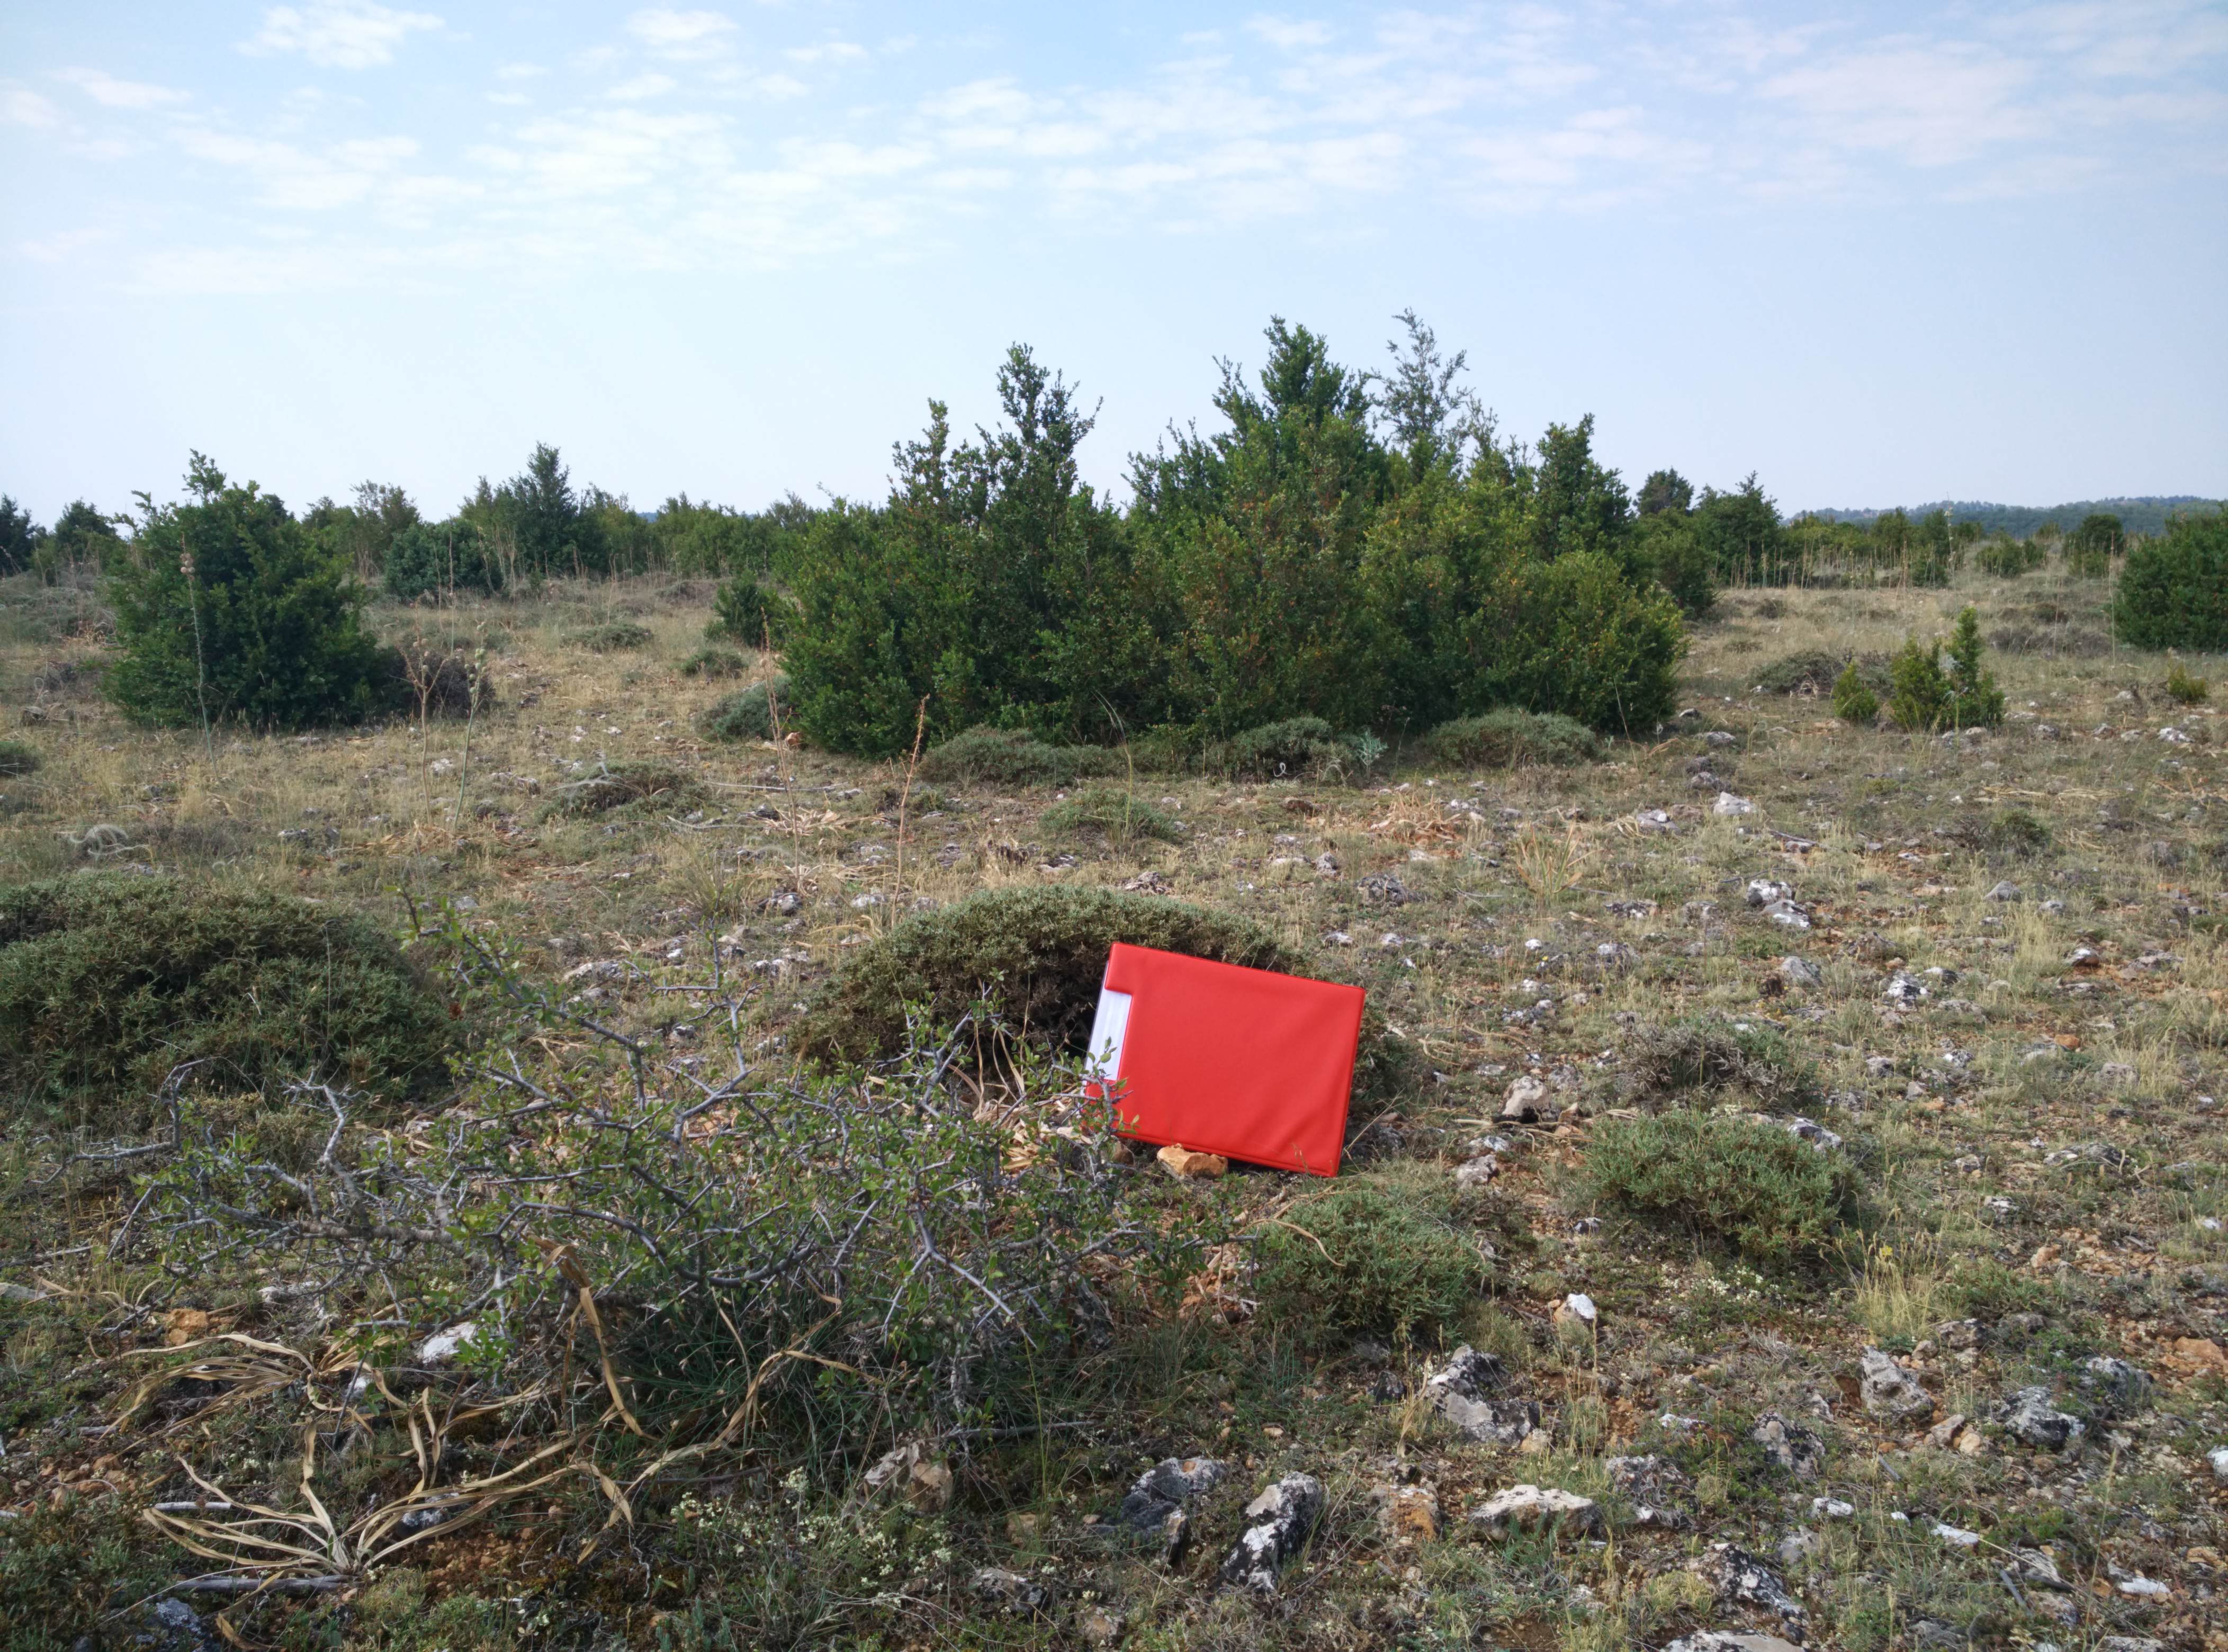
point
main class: Shrubland
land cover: Shrubland without tree cover
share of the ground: 50 - 75 %
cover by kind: shrubs 60 %, unconsolidated bare surface 35 %, herbaceous plants 5 %
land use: Semi-natural and natural areas not in use
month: June
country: ES
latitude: 40.6986
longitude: -1.9865
